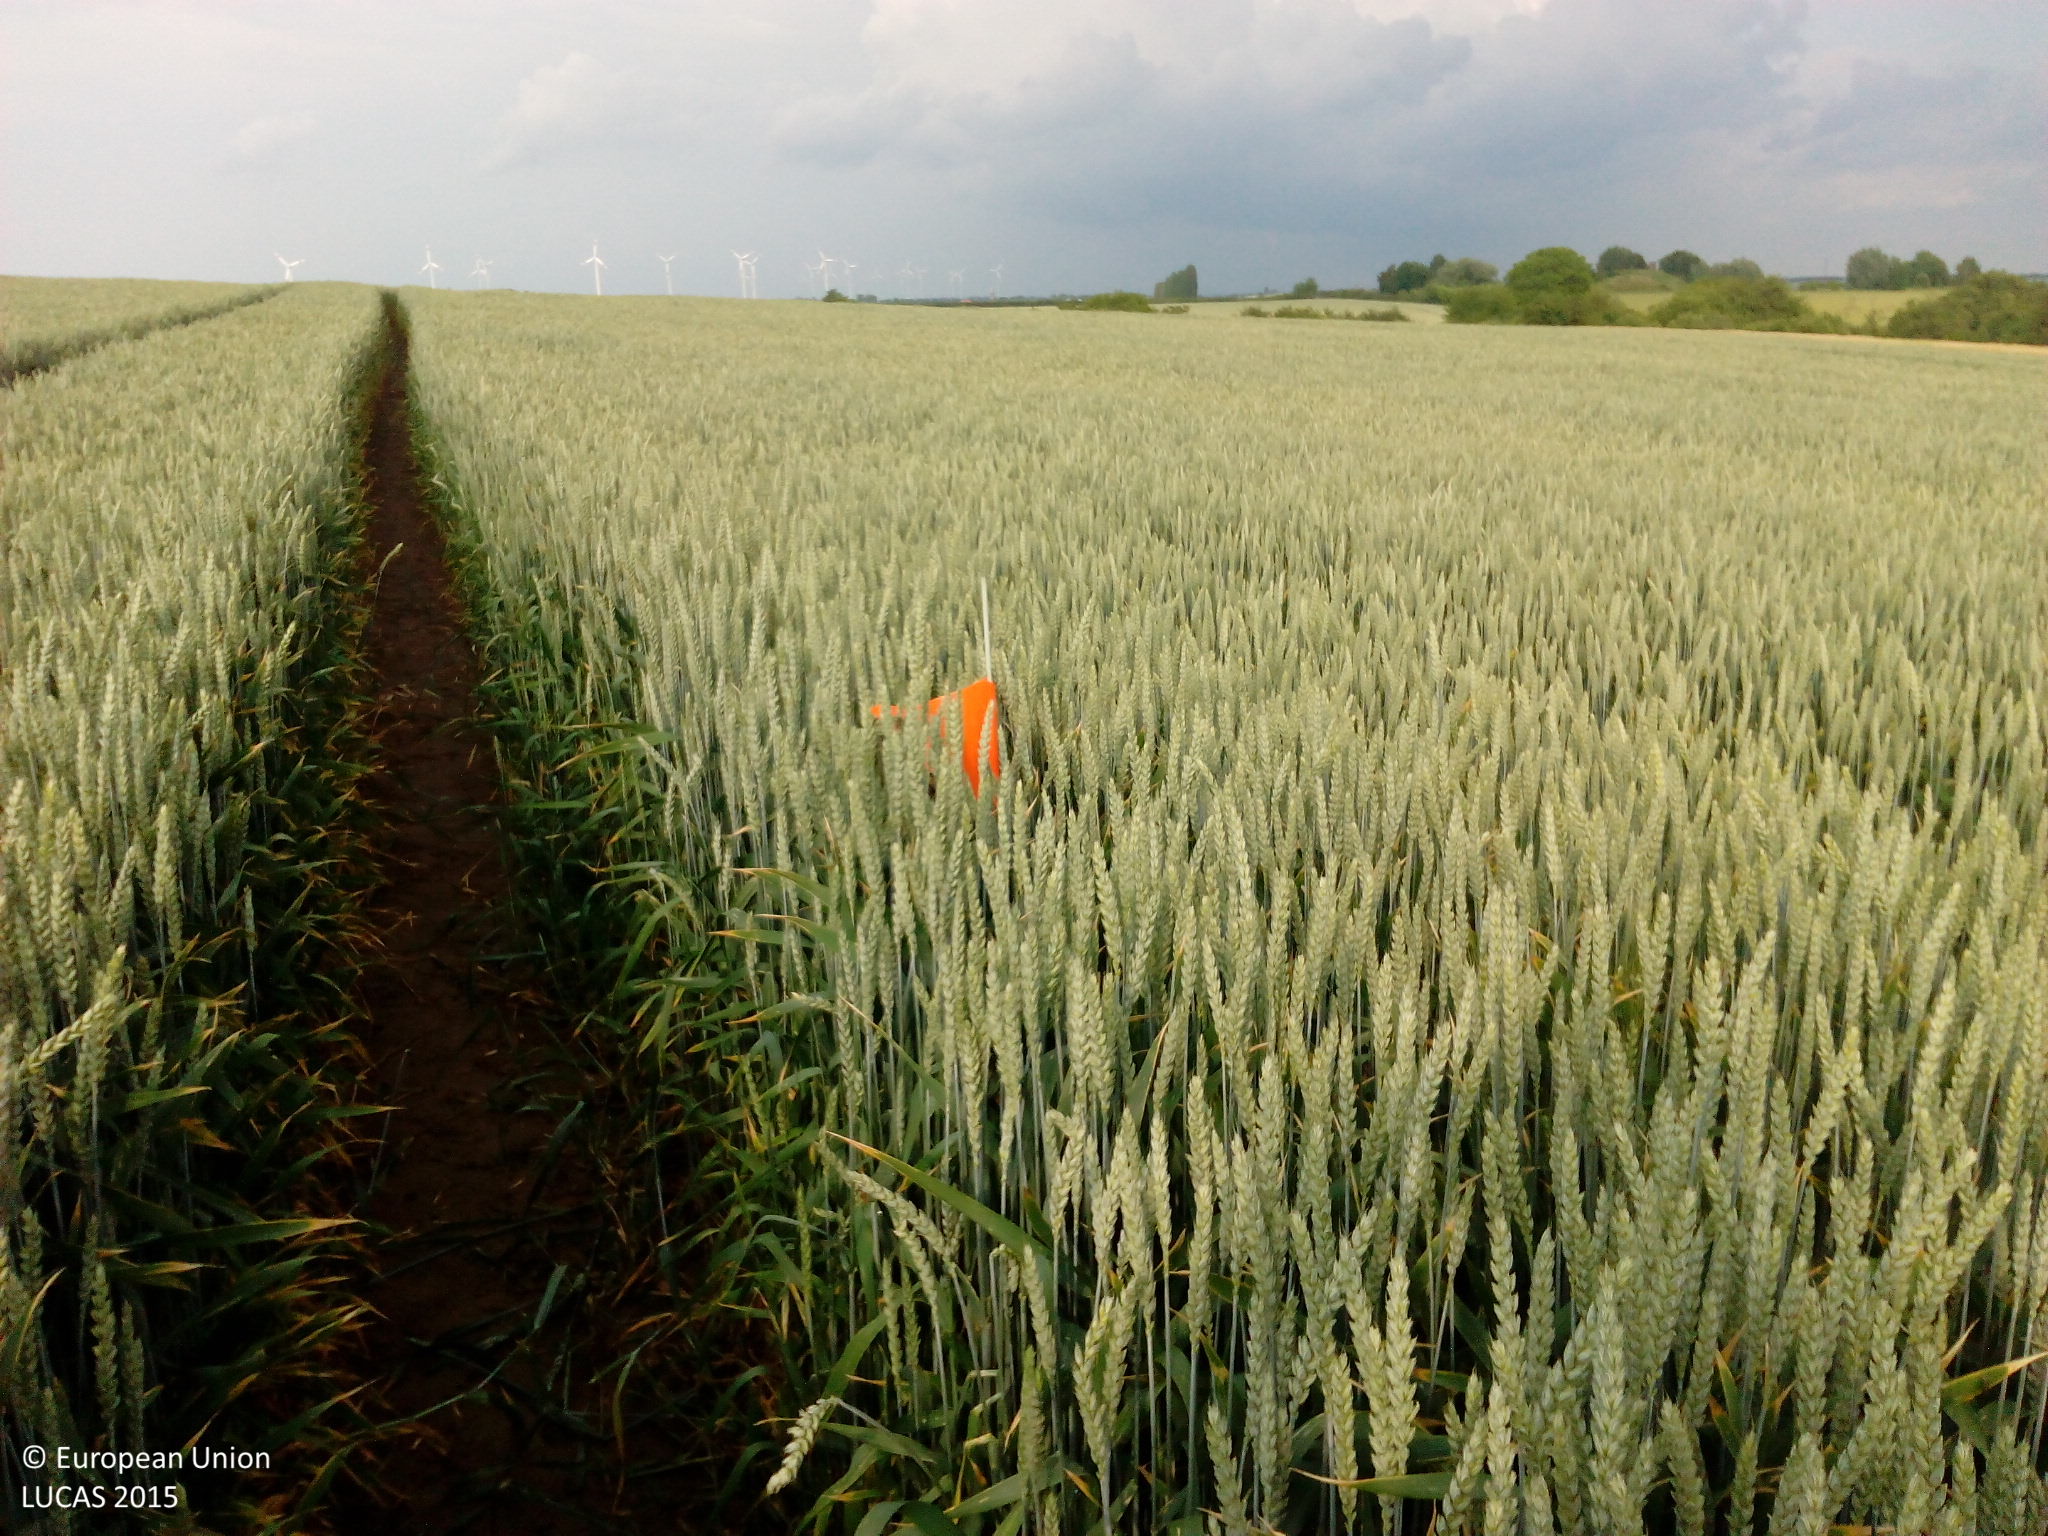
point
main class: Cropland
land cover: Common wheat
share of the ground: > 75 %
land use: Agriculture (excluding fallow land and kitchen gardens)
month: June
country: DE
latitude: 51.3971
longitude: 11.5088
